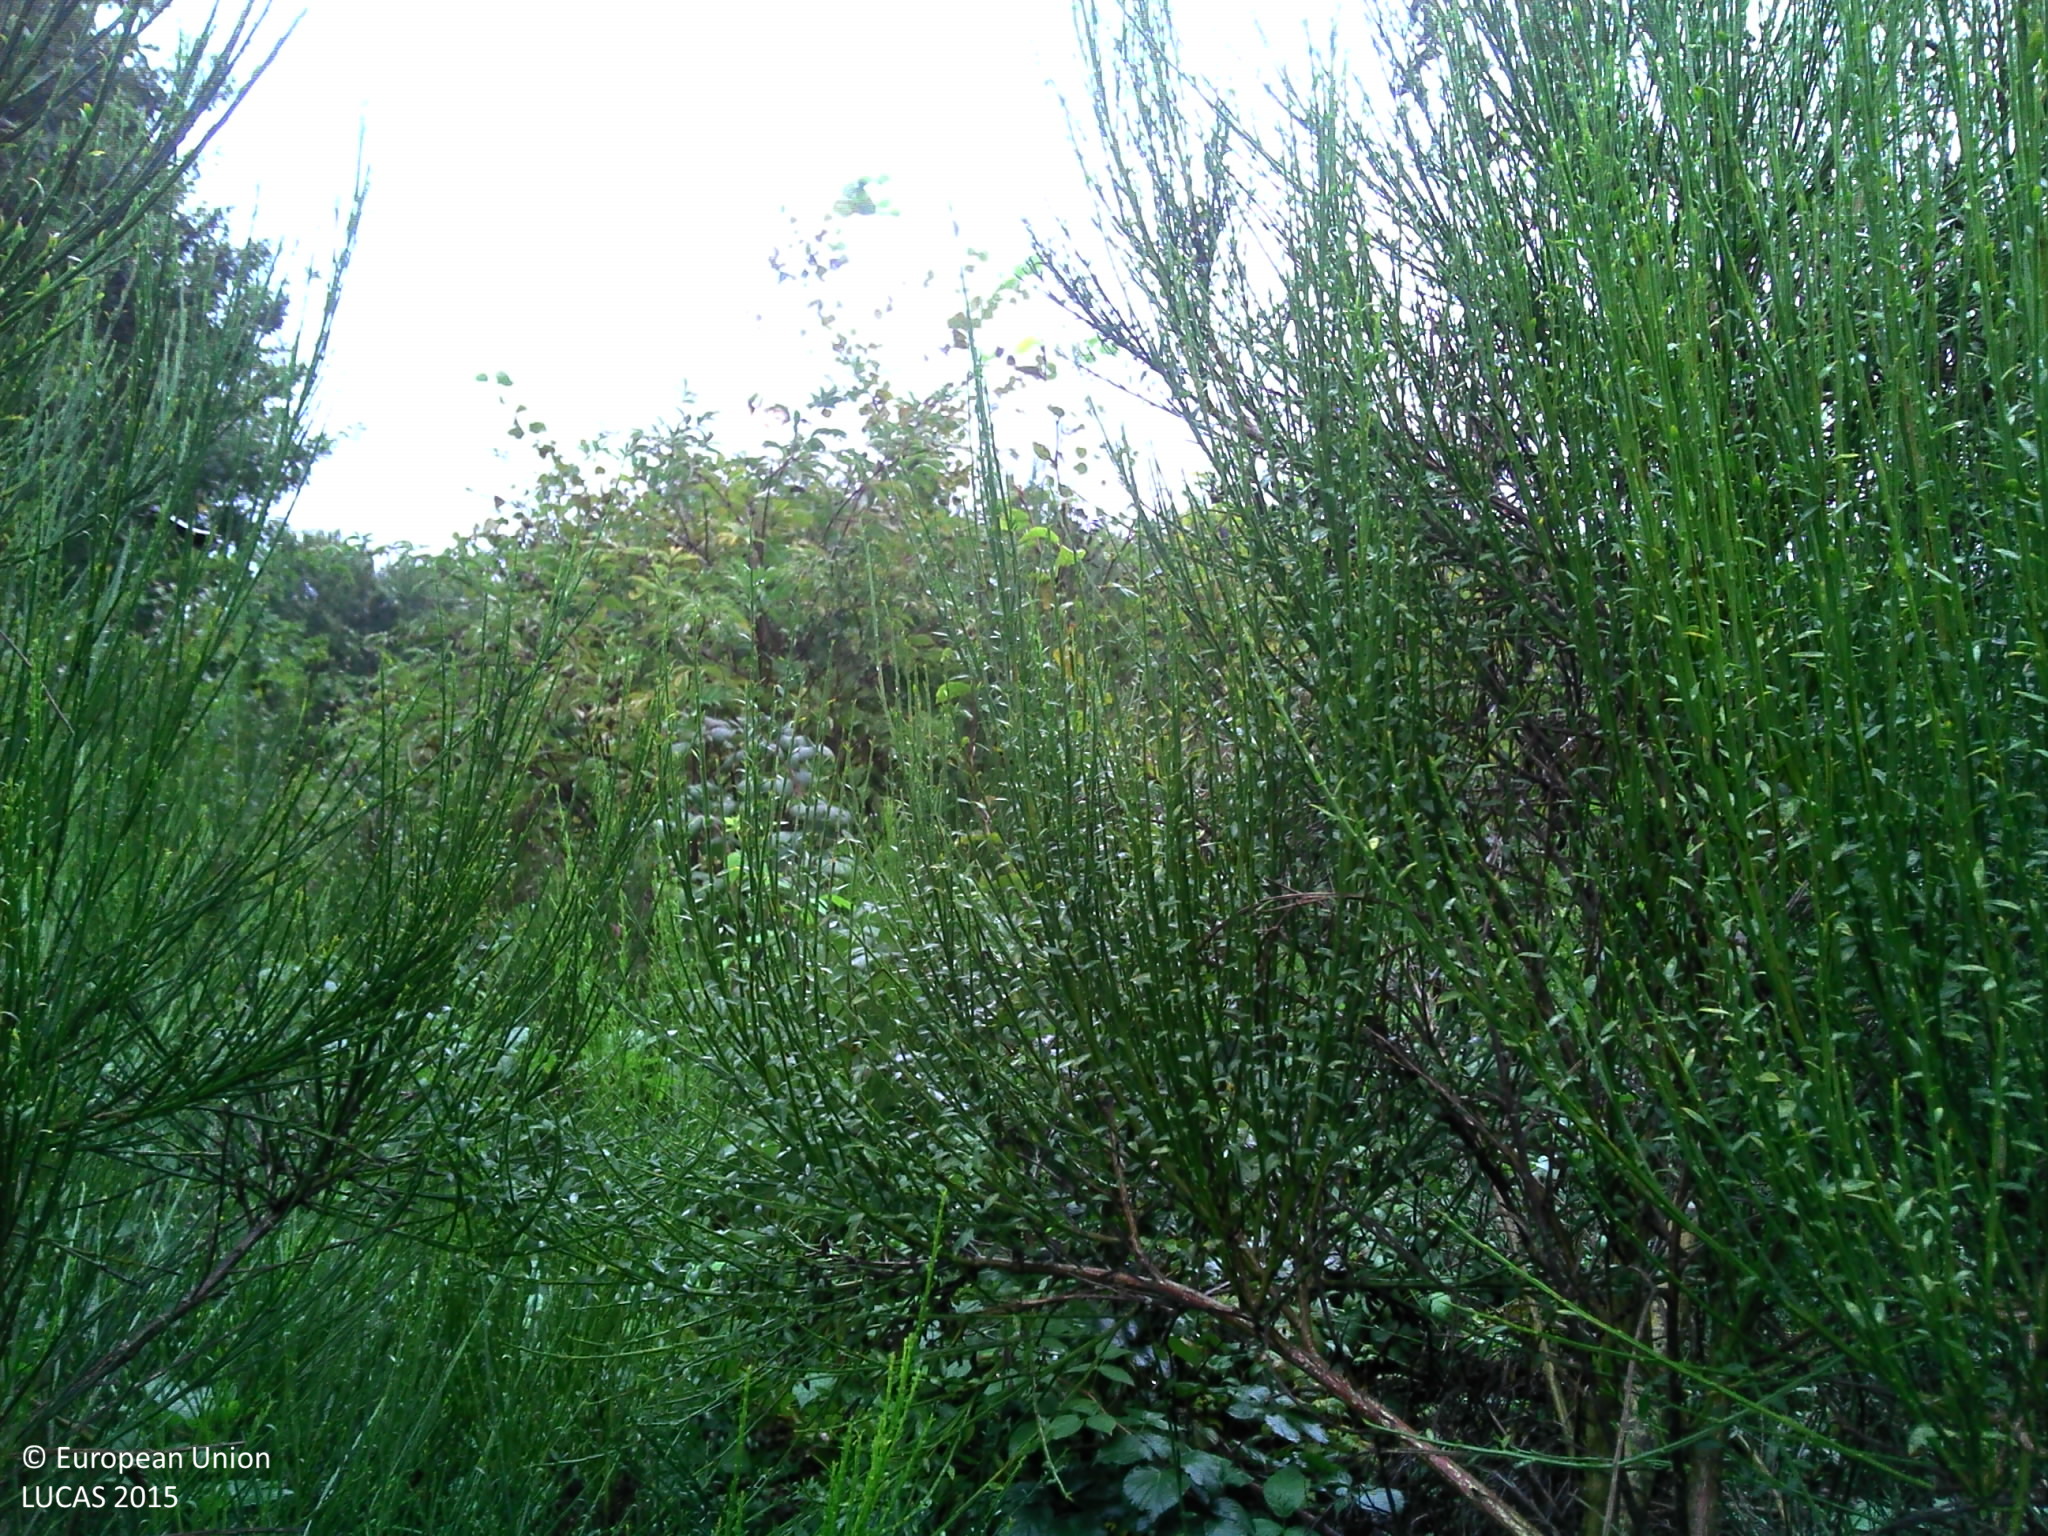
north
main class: Shrubland
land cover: Shrubland with sparse tree cover
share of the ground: > 75 %
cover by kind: shrubs 95 %, broadleaved forest trees 5 %
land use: Forestry
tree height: < 5 m
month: September
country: LU
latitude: 49.8045
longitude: 5.9001
